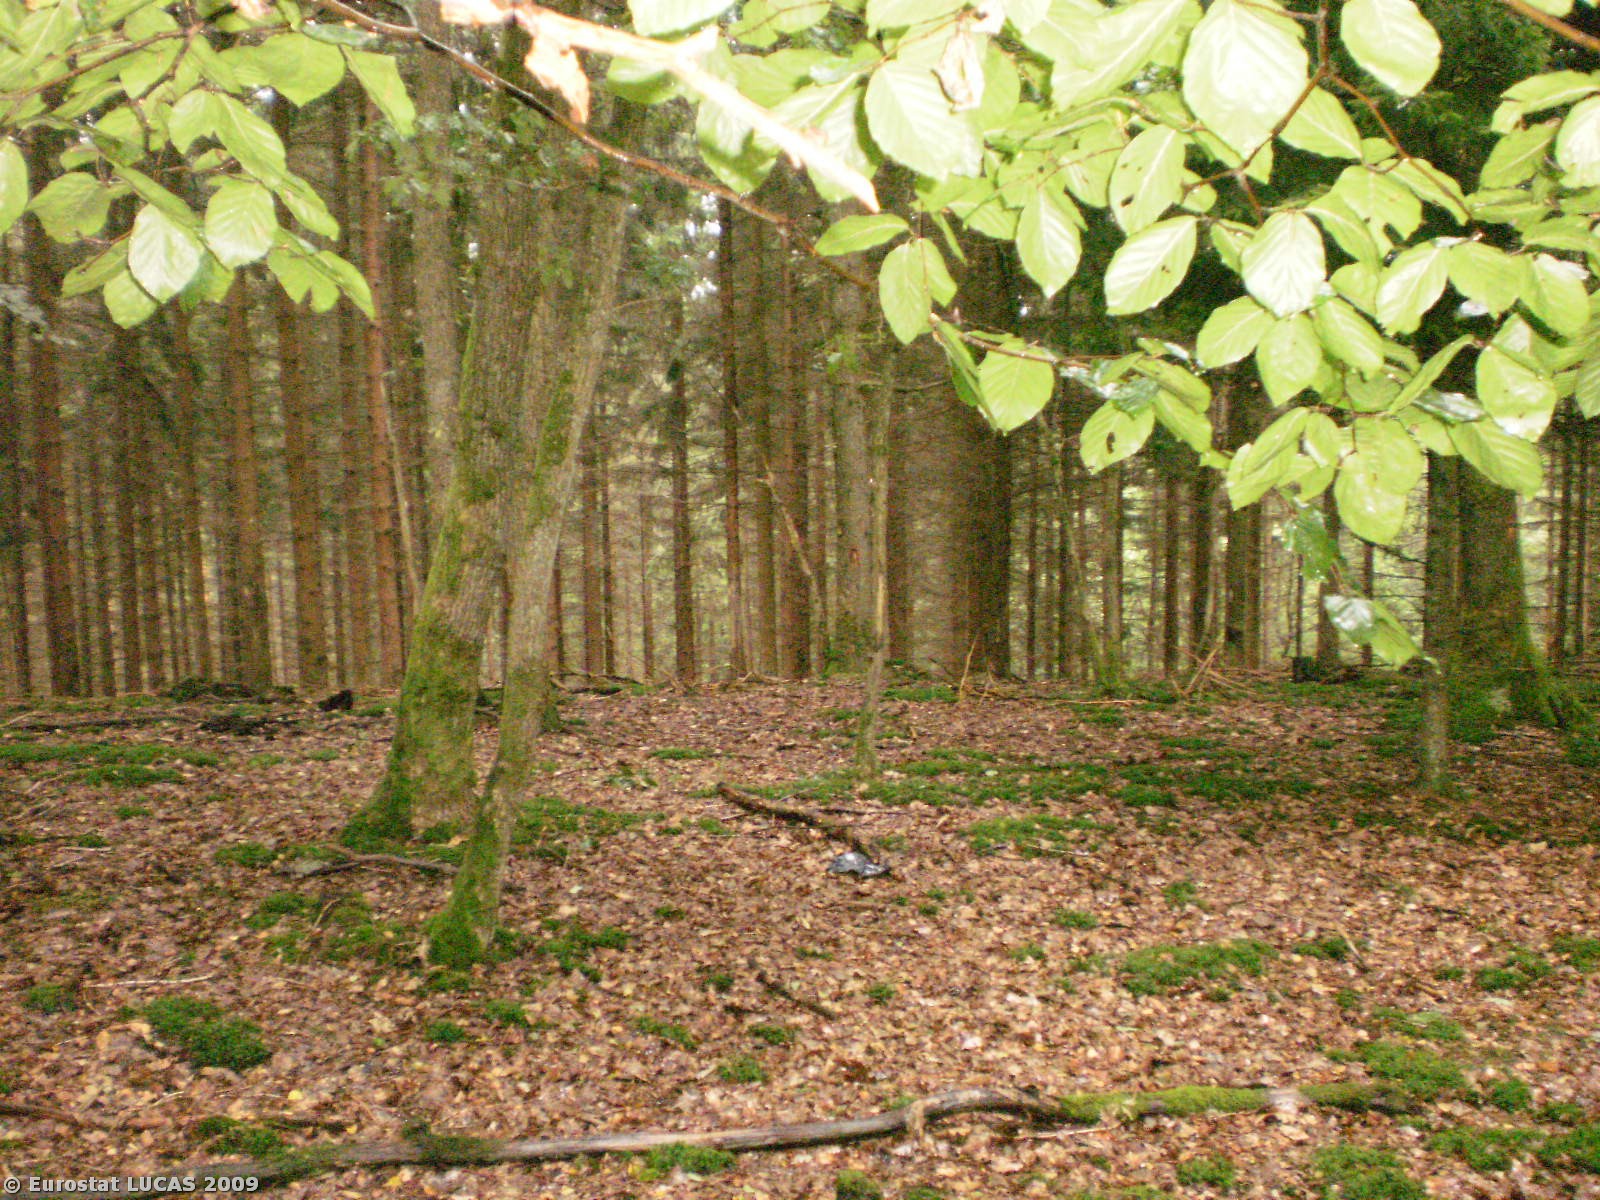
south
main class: Woodland
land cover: Broadleaved woodland
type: beech forest
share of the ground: > 75 %
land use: Nature reserves
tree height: > 5 m
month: September
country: BE
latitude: 50.3335
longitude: 5.6011
